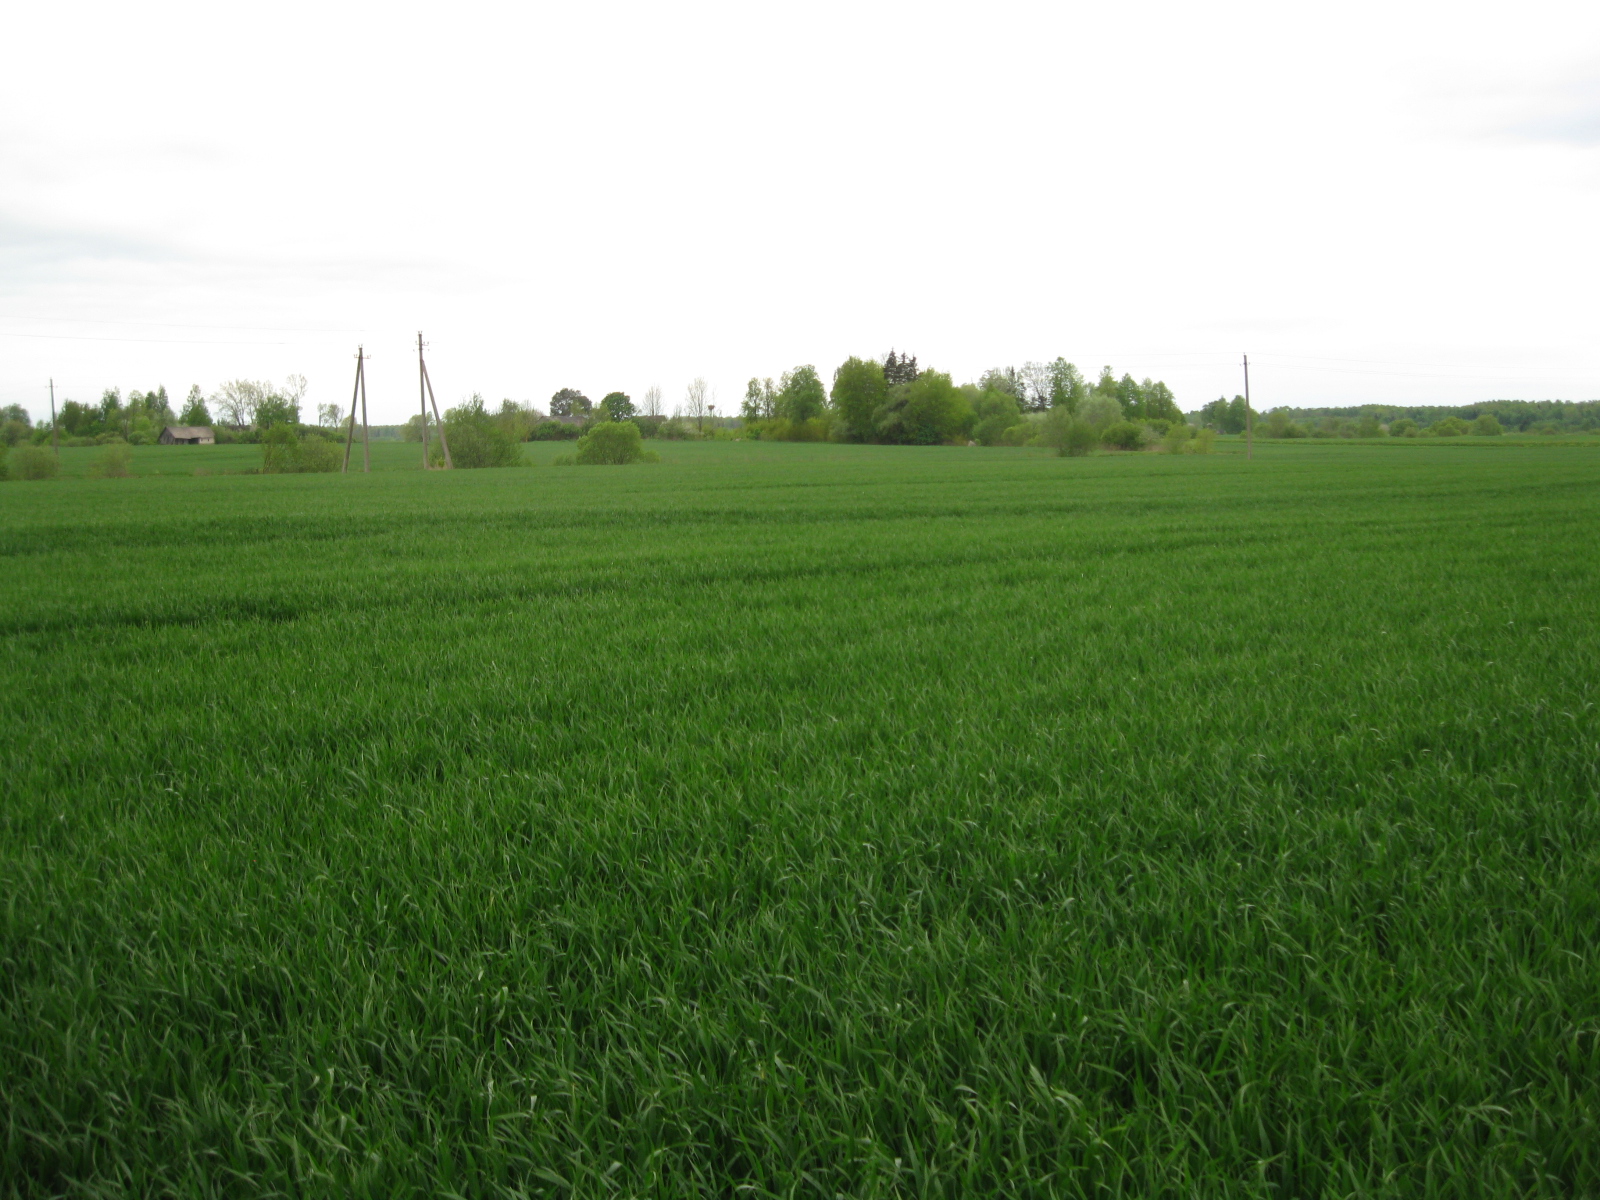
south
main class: Cropland
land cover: Common wheat
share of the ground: > 75 %
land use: Agriculture (excluding fallow land and kitchen gardens)
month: May
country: LT
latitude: 56.2311
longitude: 23.3822
